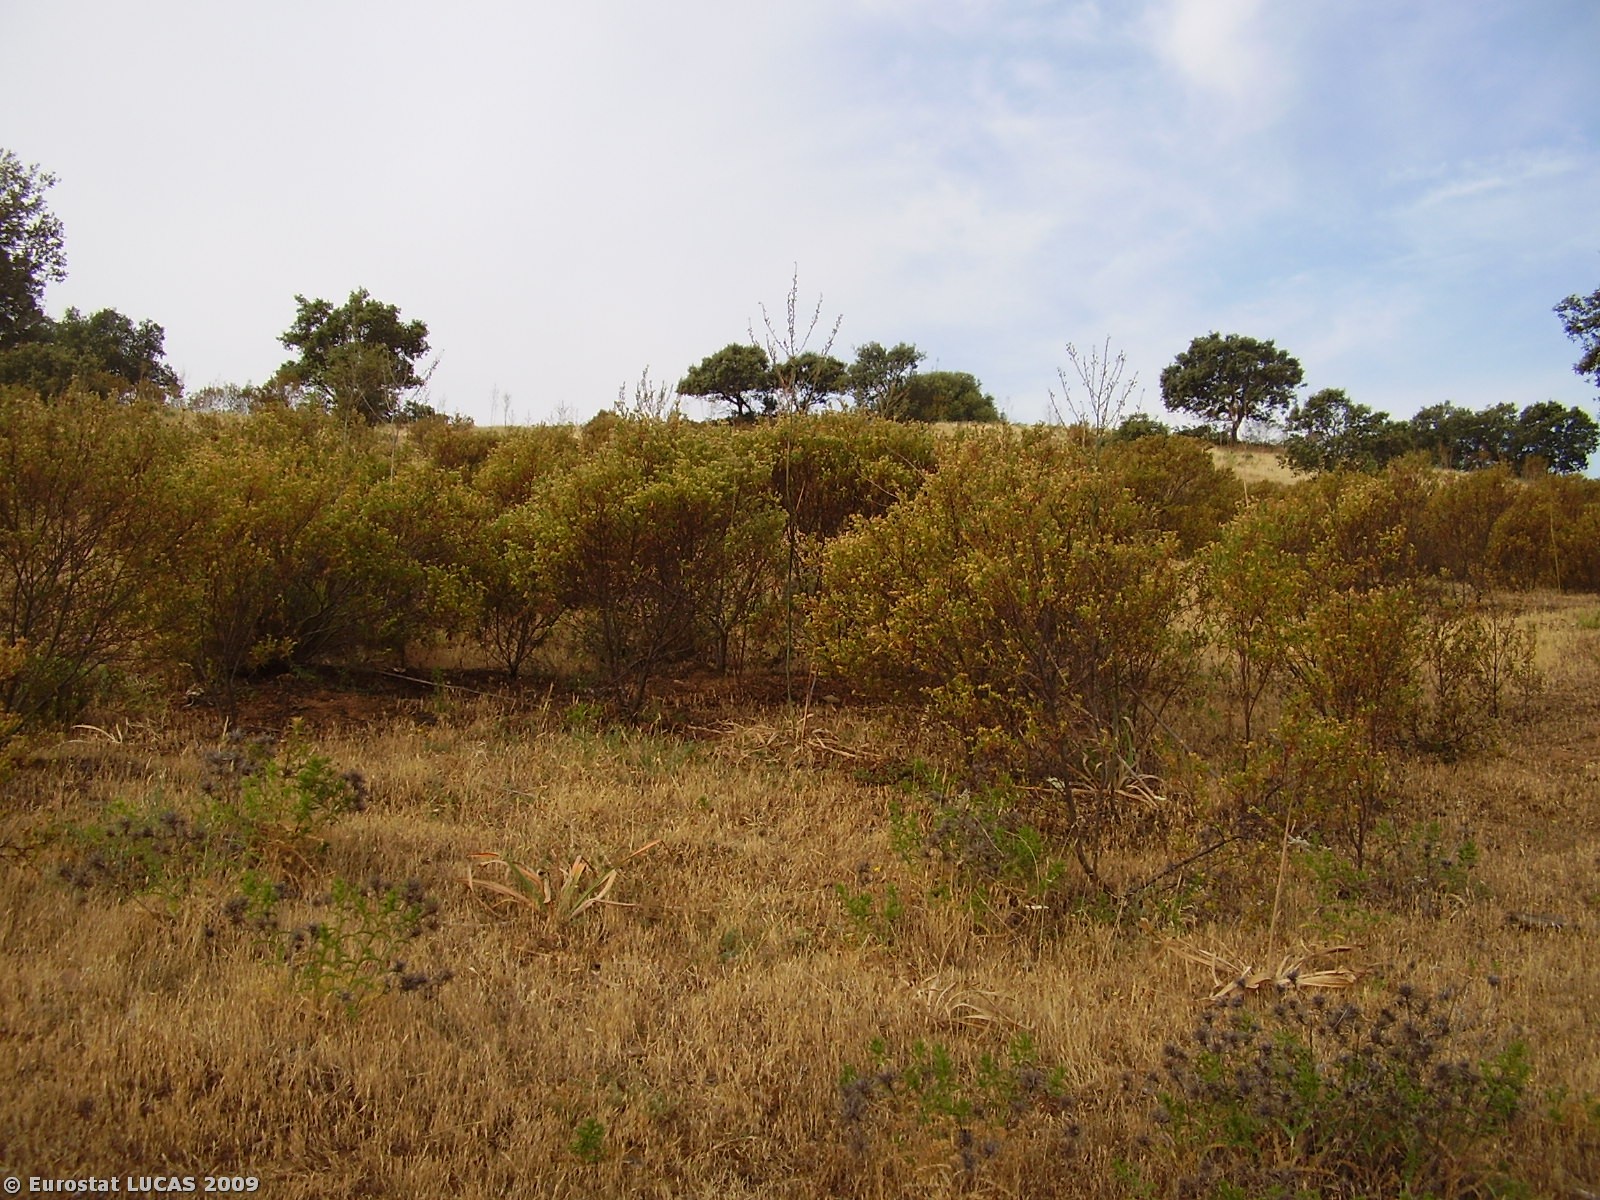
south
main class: Woodland
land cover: Broadleaved woodland
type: broadleaved evergreen forest
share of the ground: 50 - 75 %
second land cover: Spontaneously vegetated surfaces
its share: 50 - 75 %
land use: Forestry
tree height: > 5 m
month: May
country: PT
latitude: 37.5942
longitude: -7.5791
